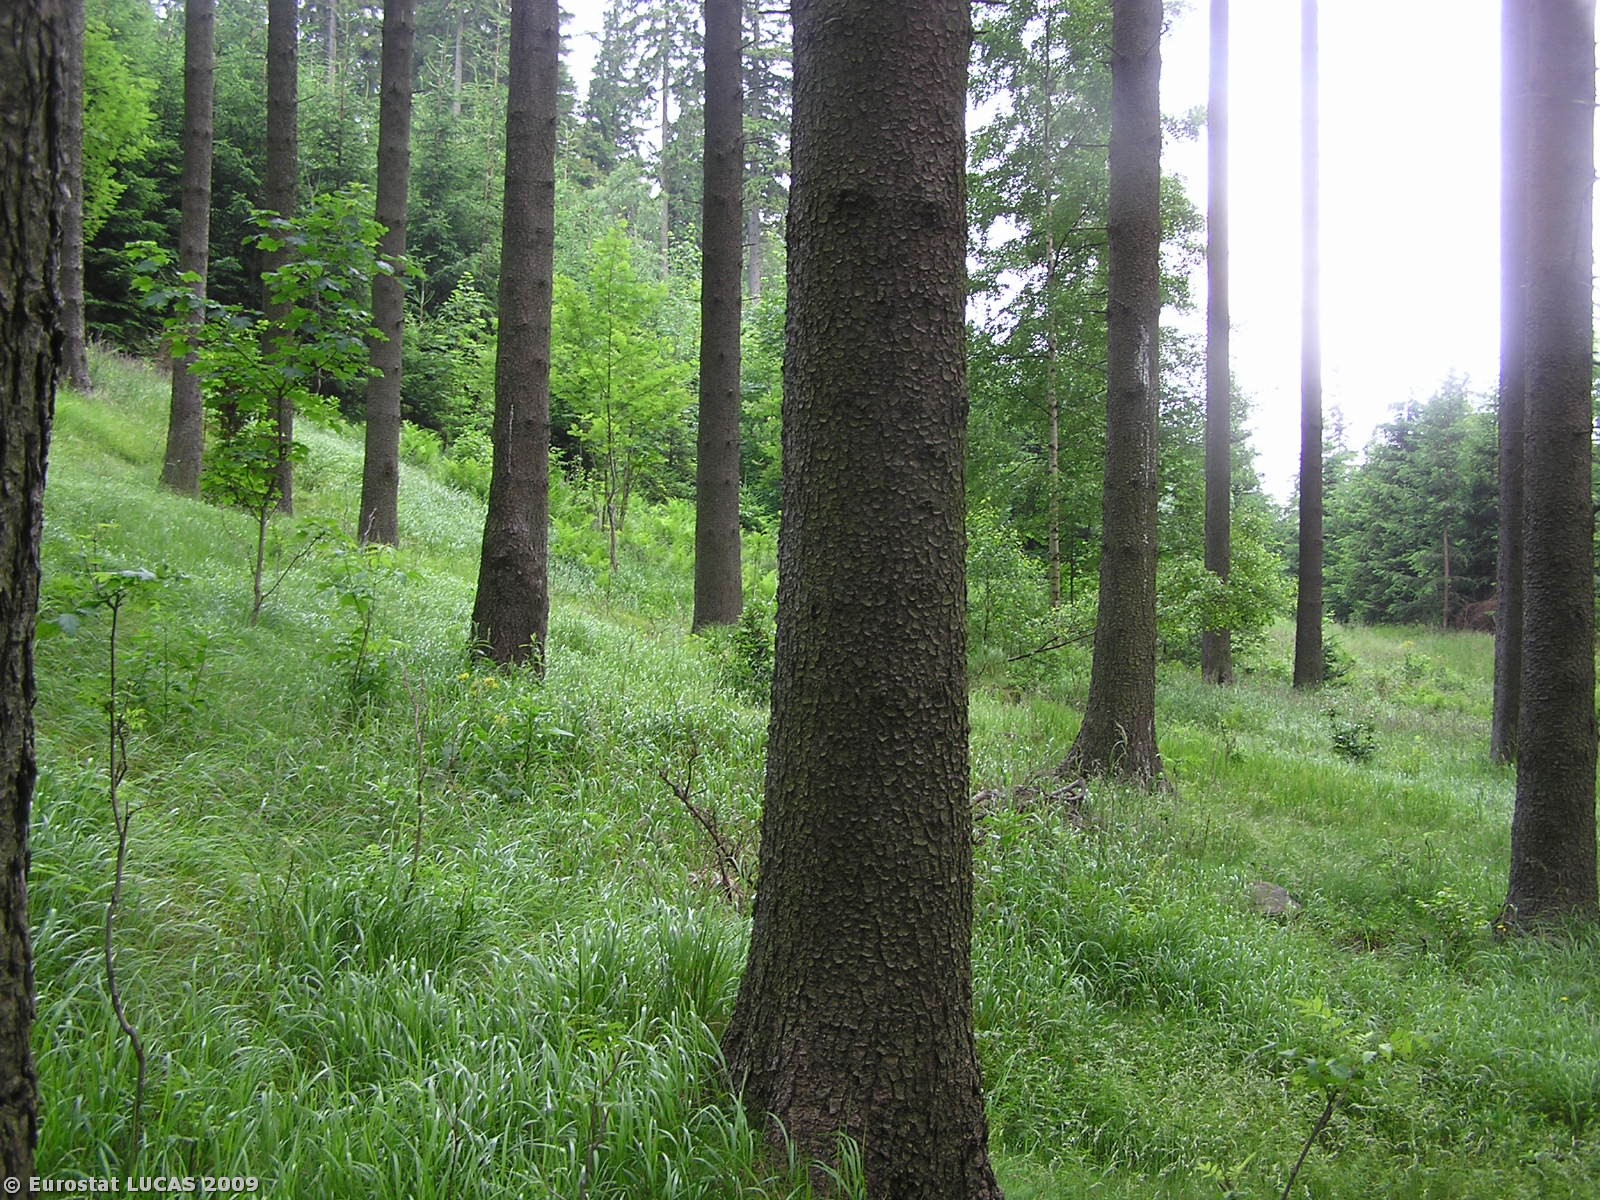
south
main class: Woodland
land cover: Coniferous woodland
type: hemiboreal forest and nemoral coniferous forest and mixed broadleaved-coniferous forest
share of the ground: > 75 %
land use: Forestry
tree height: > 5 m
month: June
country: CZ
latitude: 50.0395
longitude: 17.3138
